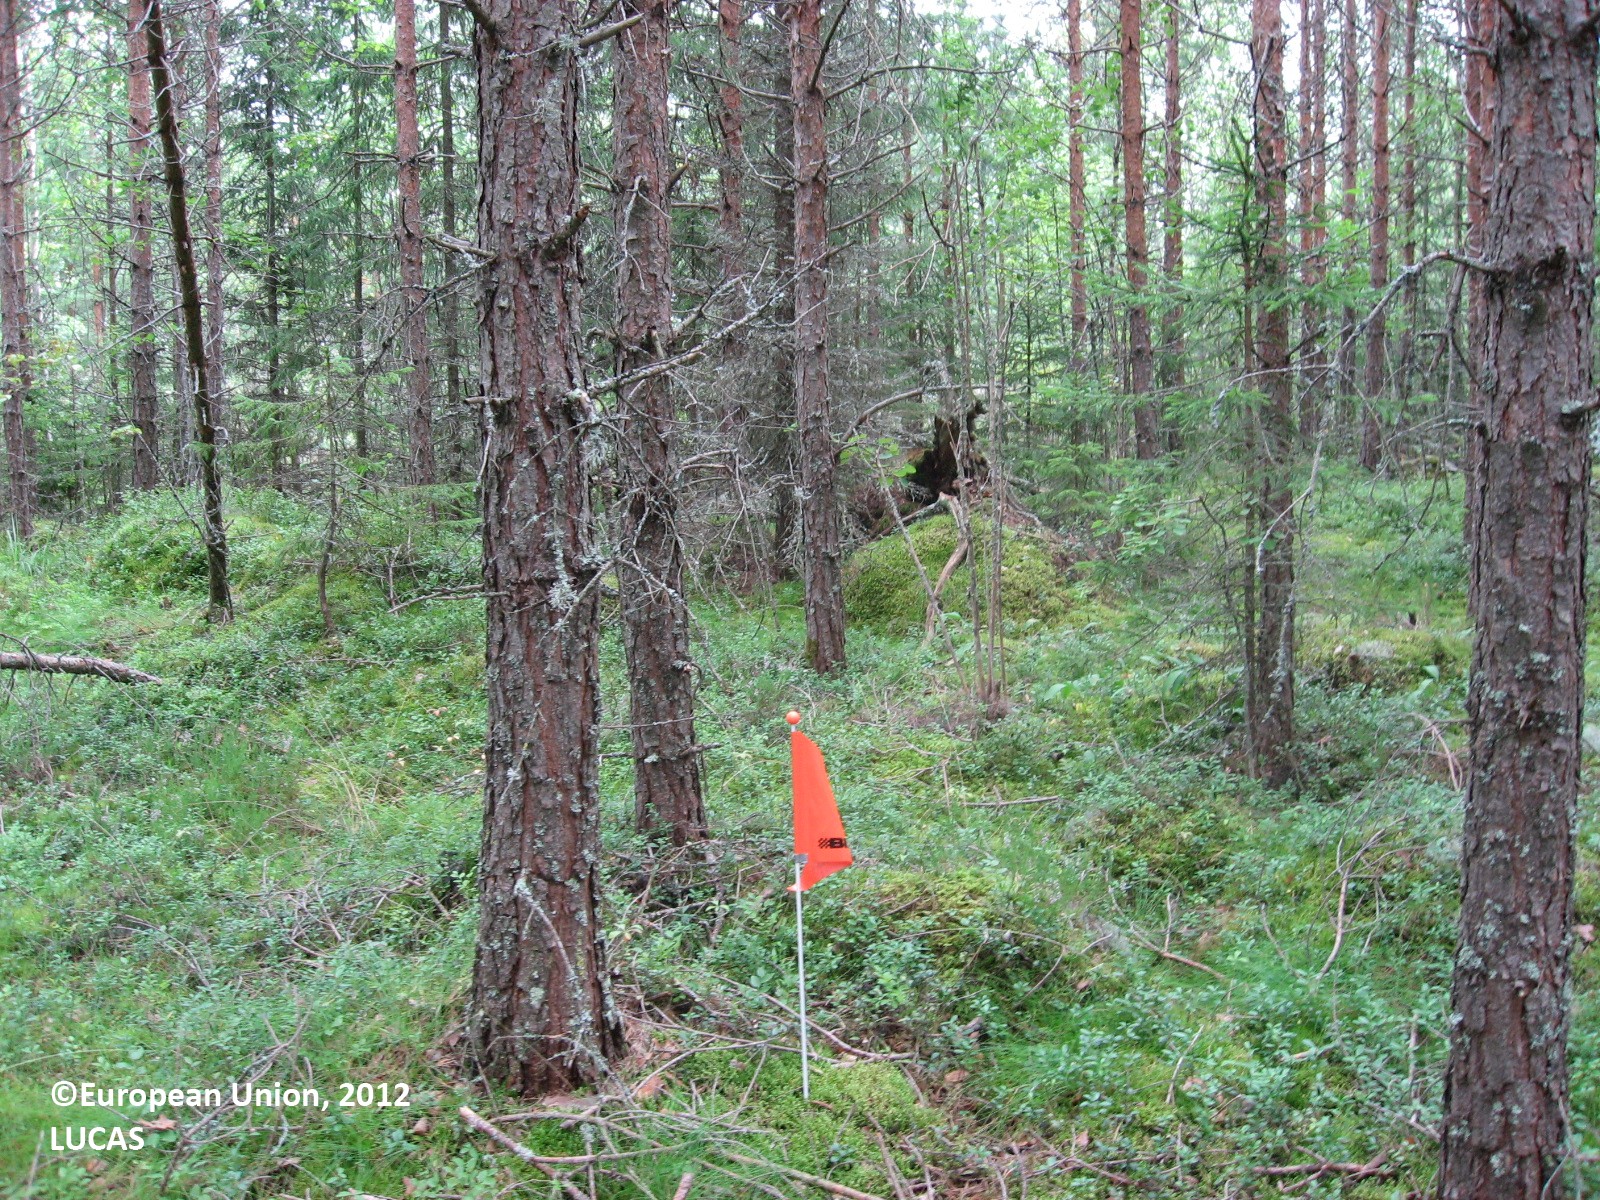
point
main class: Woodland
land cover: Pine dominated coniferous woodland
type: boreal forest
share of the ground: > 75 %
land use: Forestry
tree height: > 5 m
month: August
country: FI
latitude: 60.7280
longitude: 25.5480
